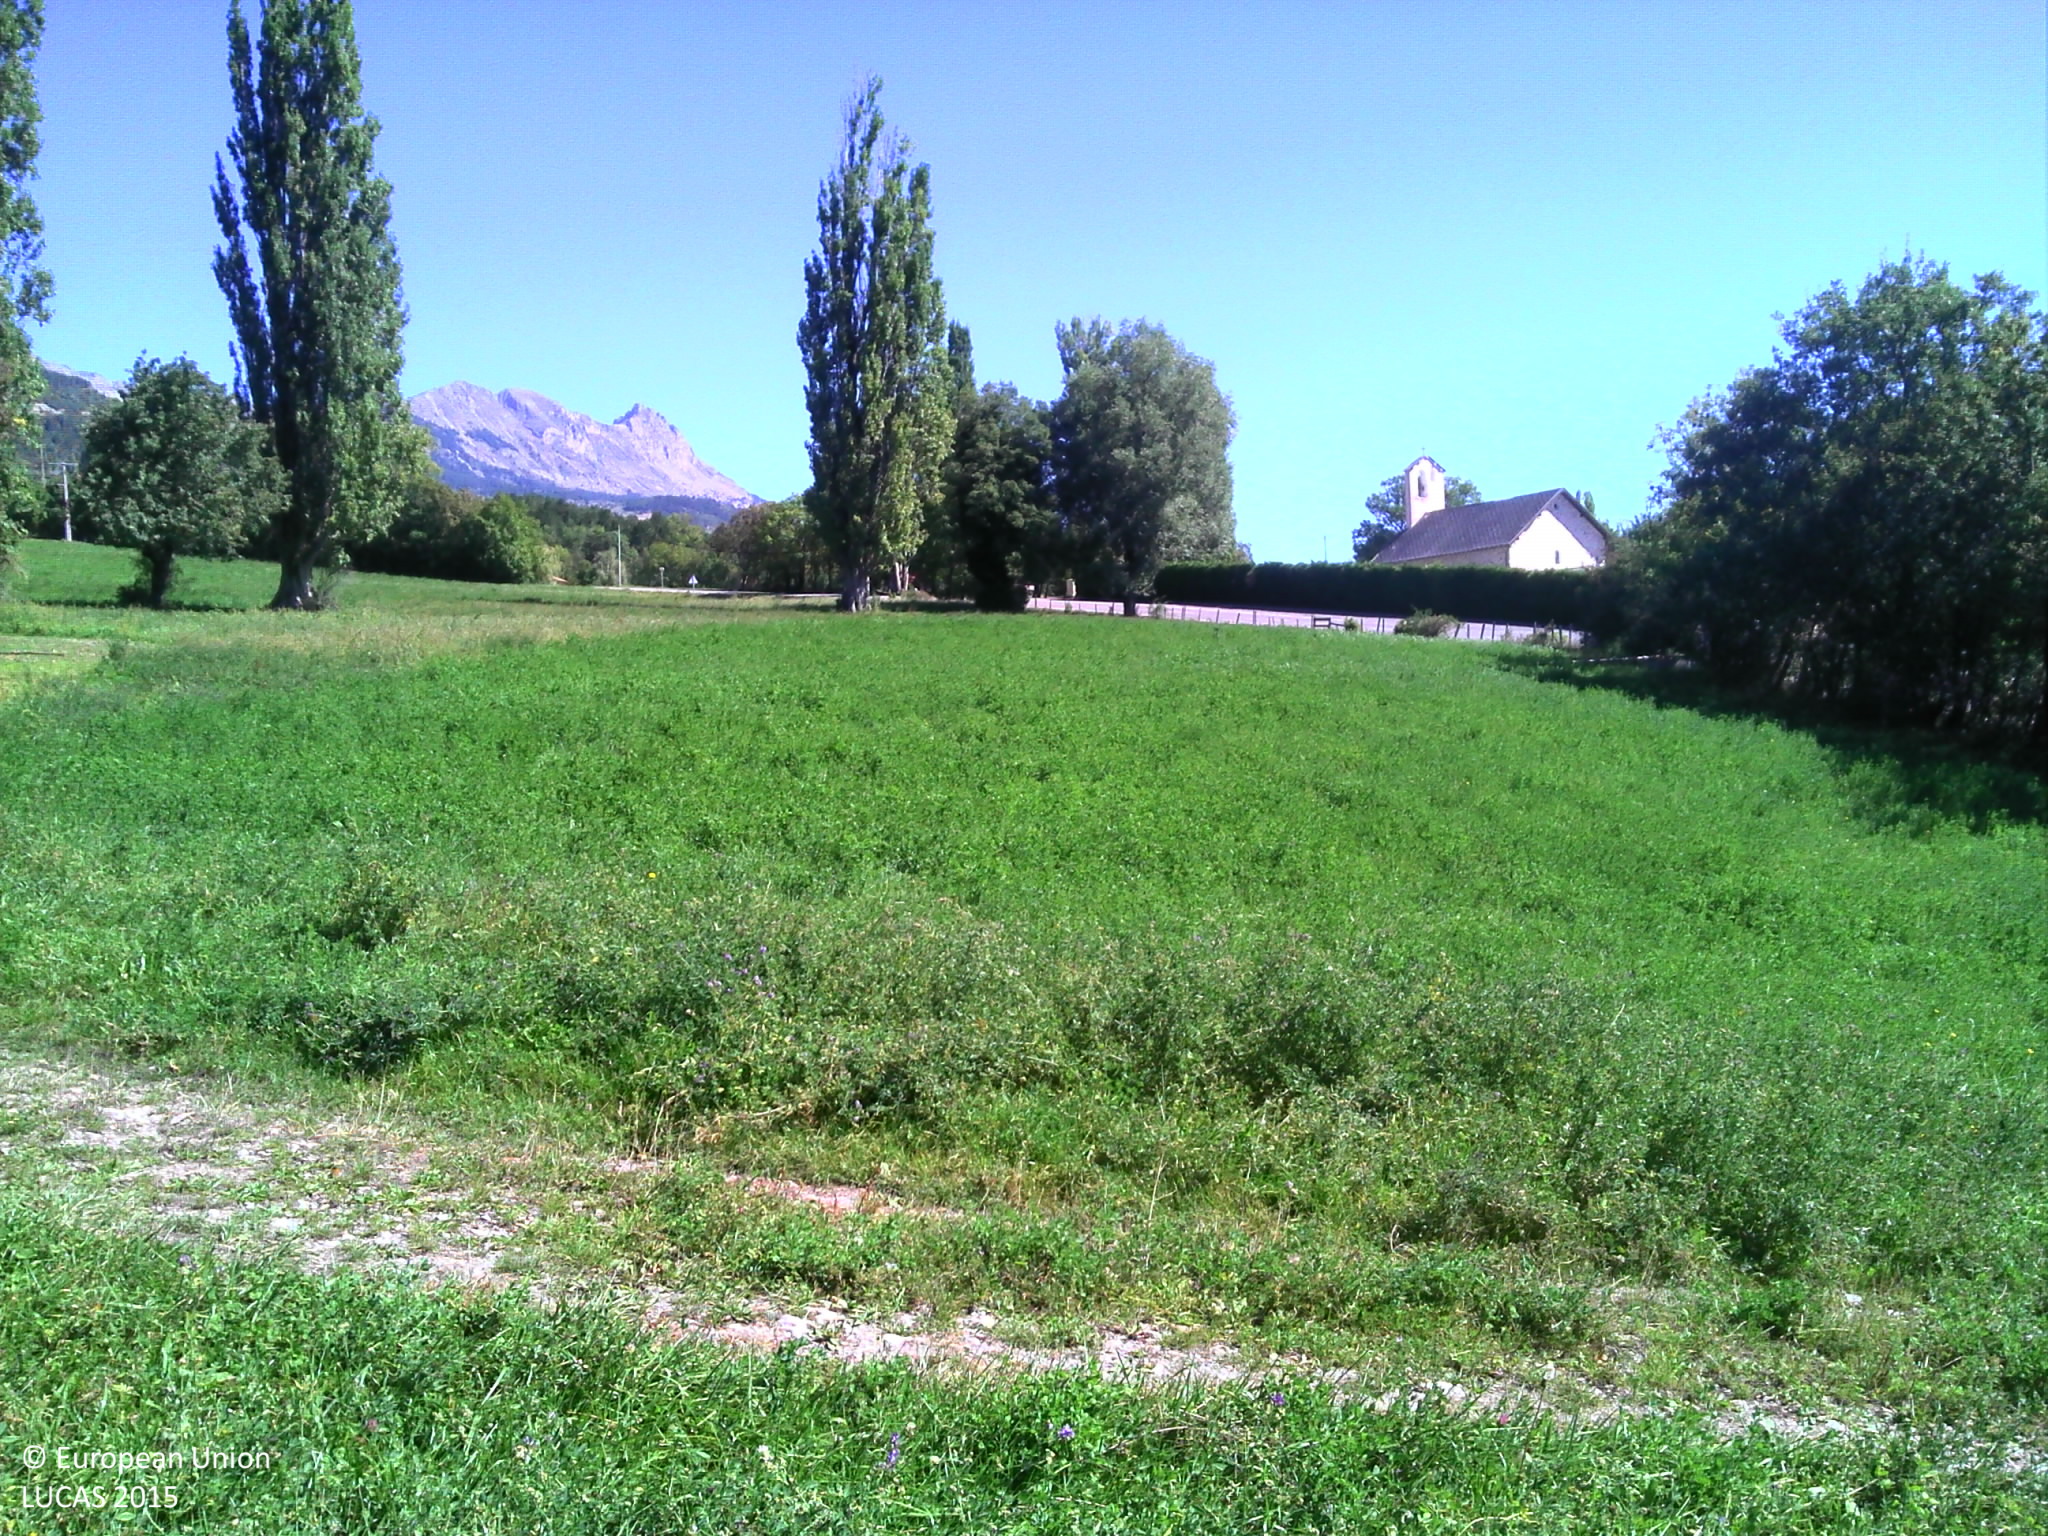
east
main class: Cropland
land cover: Lucerne
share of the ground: > 75 %
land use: Agriculture (excluding fallow land and kitchen gardens)
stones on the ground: < 10 %
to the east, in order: Lucerne; Tracks; Lucerne; Grassland without tree/shrub cover; Lines of trees; Grassland without tree/shrub cover; Fences; Ditches and canals; Grass margins; Paved roads, cycling and walking lanes; Grass margins; Electric lines; Ditches and canals; Grass margins; Broadleaved woodland; Grass margins; Paved roads, cycling and walking lanes; Grass margins; Ditches and canals; Grassland without tree/shrub cover
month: September
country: FR
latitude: 44.5704
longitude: 6.2163
